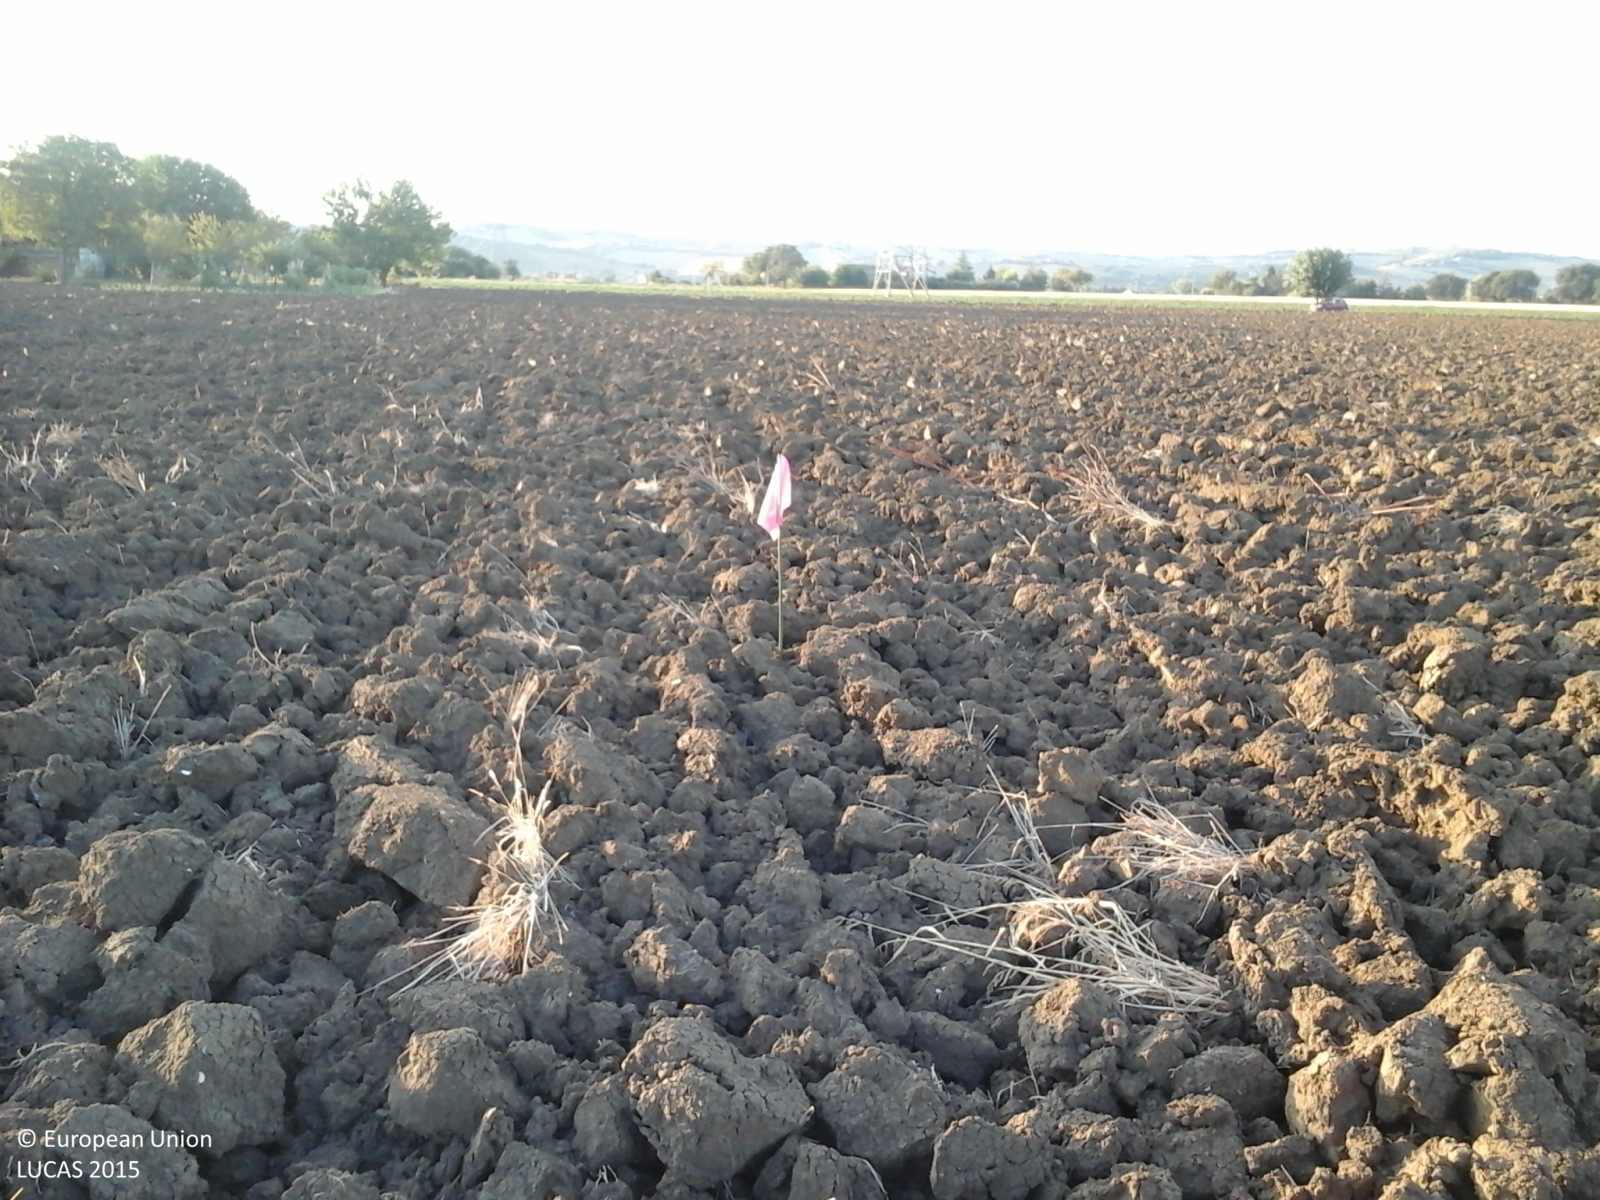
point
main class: Cropland
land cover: Oats
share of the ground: < 10 %
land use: Agriculture (excluding fallow land and kitchen gardens)
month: September
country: IT
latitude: 43.7848
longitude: 12.9628
